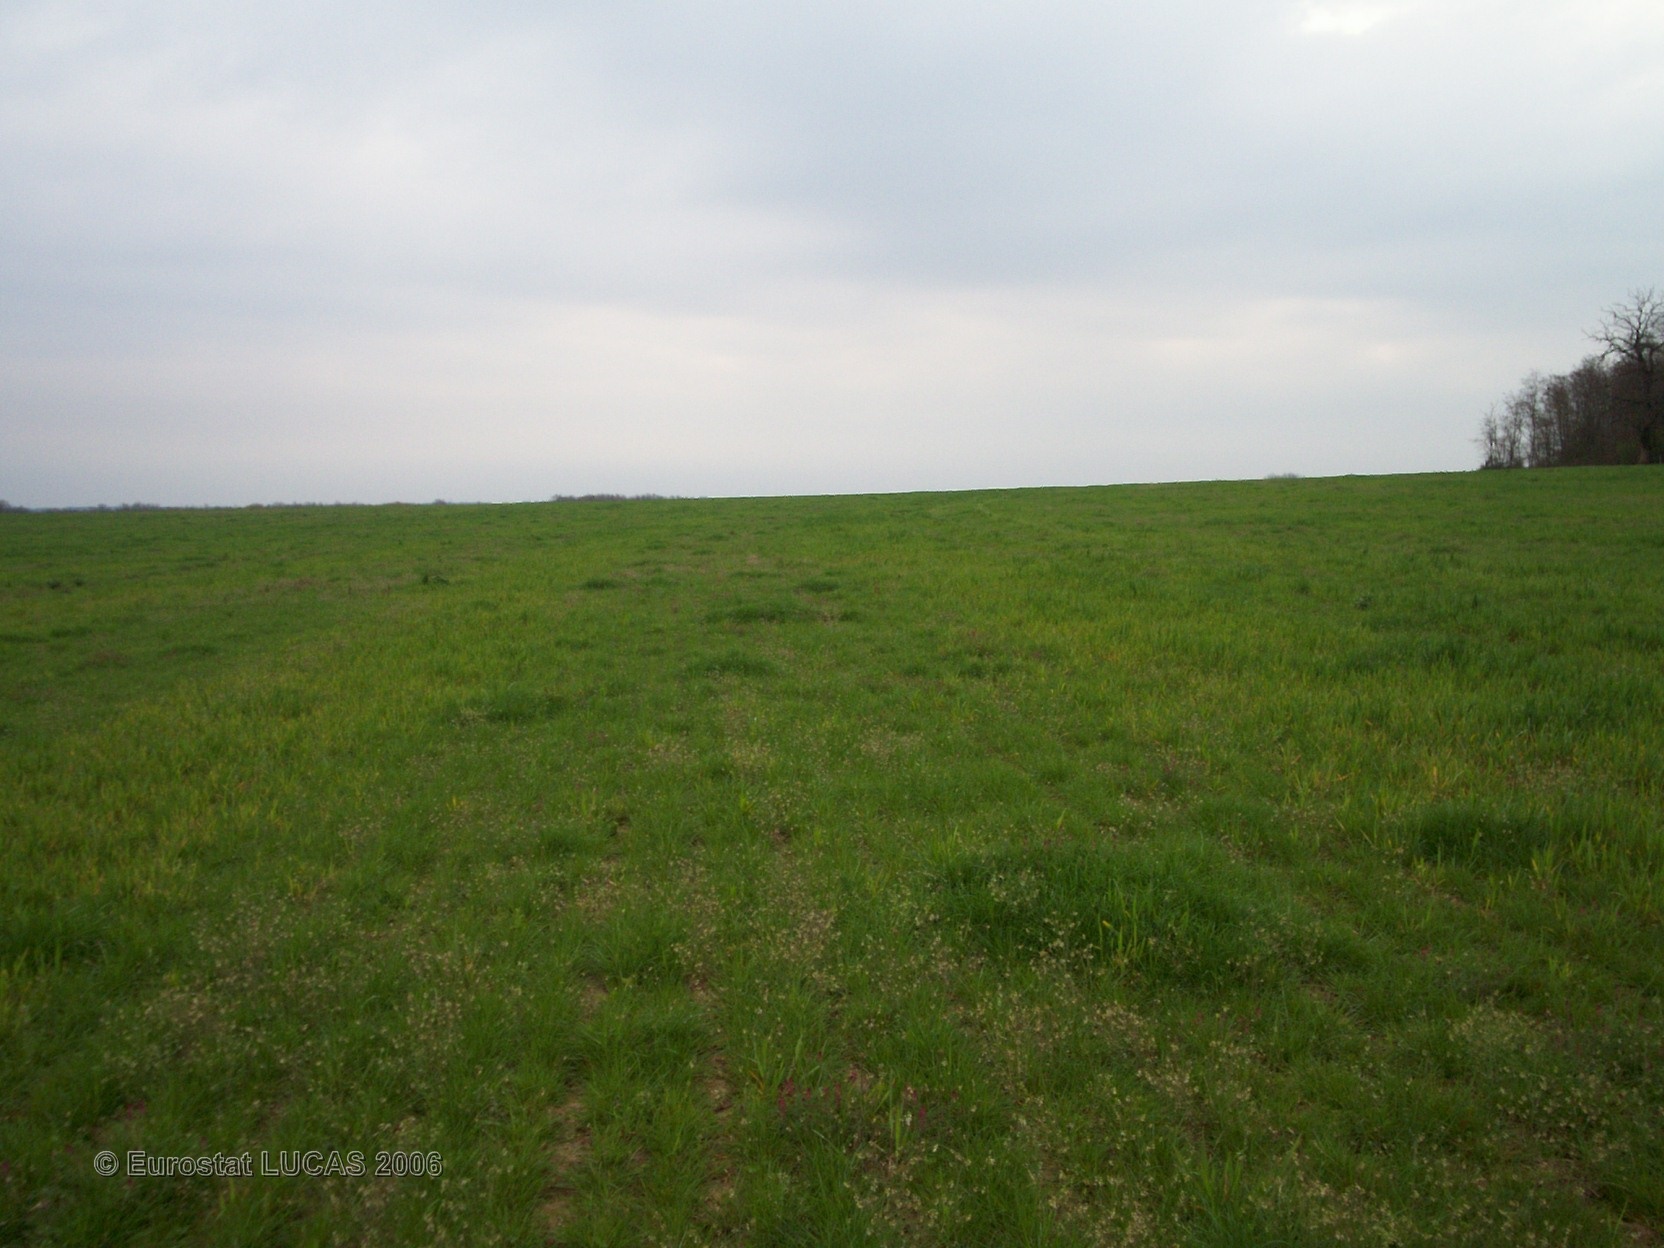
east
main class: Grassland
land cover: Grassland without tree/shrub cover
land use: Agriculture (excluding fallow land and kitchen gardens)
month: April
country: FR
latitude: 46.5731
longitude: 1.0487
